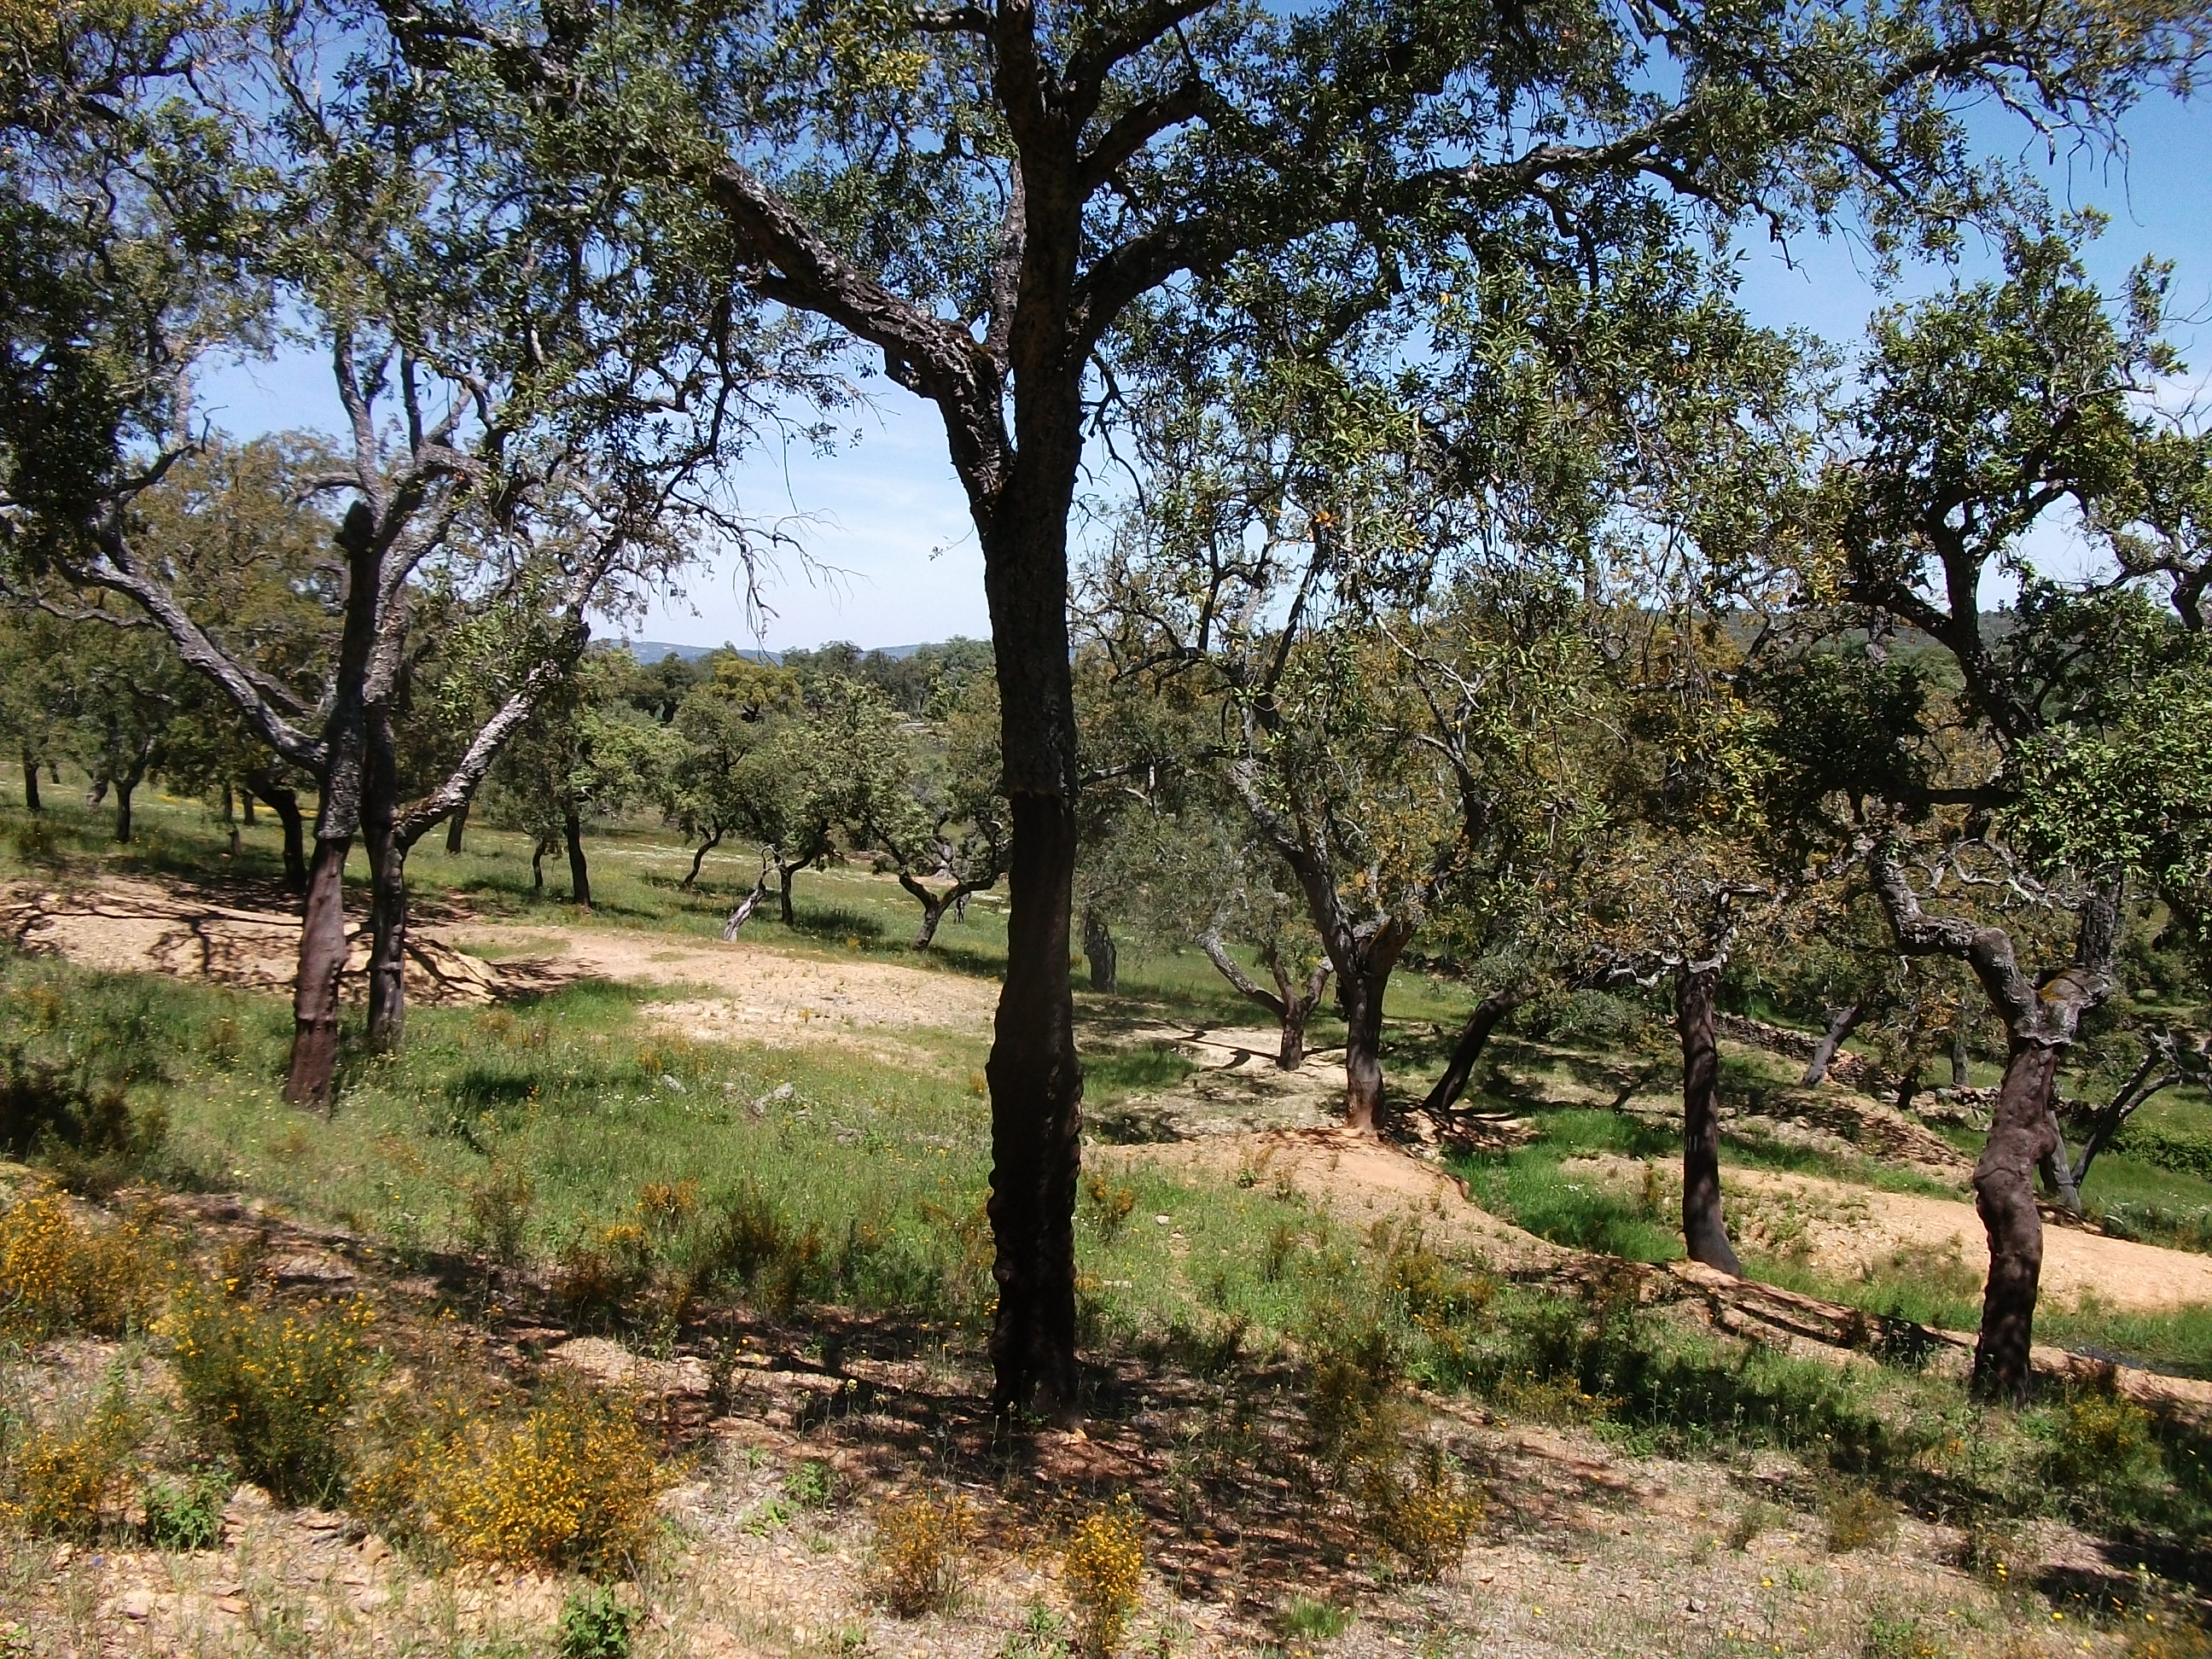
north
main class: Woodland
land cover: Broadleaved woodland
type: broadleaved evergreen forest
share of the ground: 50 - 75 %
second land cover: Spontaneously vegetated surfaces
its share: 10 - 25 %
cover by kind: broadleaved forest trees 70 %, herbaceous plants 20 %, shrubs 10 %
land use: Forestry
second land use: Agriculture (excluding fallow land and kitchen gardens)
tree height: > 5 m
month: April
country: ES
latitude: 37.7617
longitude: -6.5569
